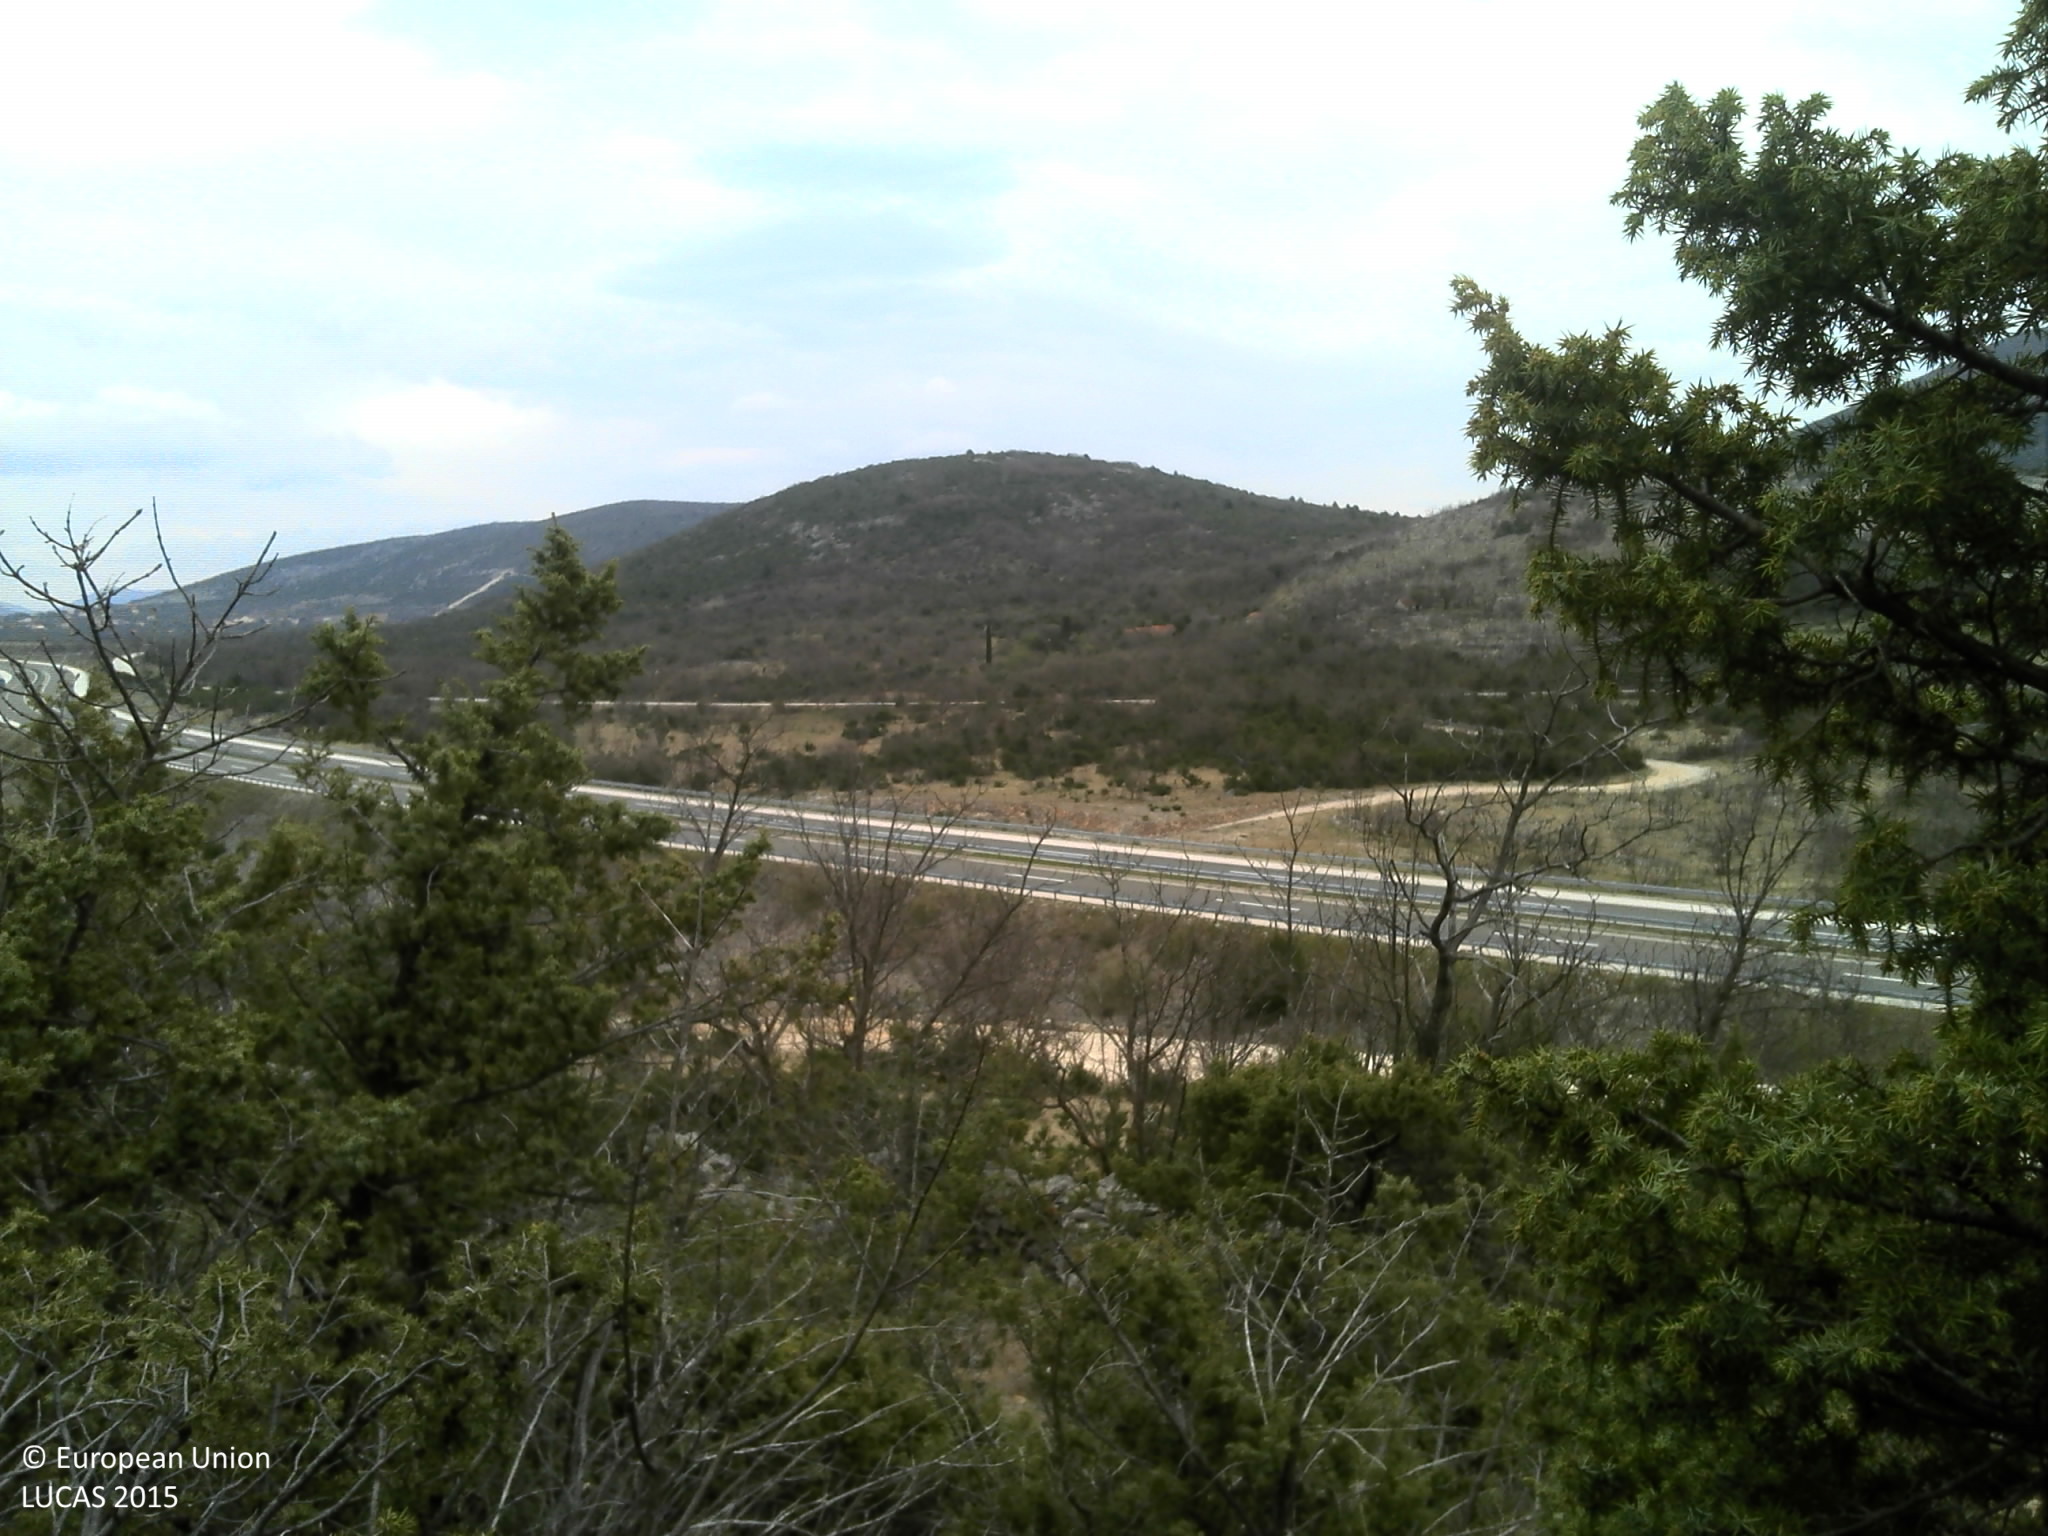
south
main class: Woodland
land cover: Other mixed woodland
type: coniferous forest of the mediterranean region
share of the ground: 50 - 75 %
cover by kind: coniferous forest trees 35 %, shrubs 25 %, broadleaved forest trees 15 %, consolidated bare surface 10 %, unconsolidated bare surface 10 %, herbaceous plants 5 %
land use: Semi-natural and natural areas not in use
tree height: < 5 m
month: April
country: HR
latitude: 43.6838
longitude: 16.0820
